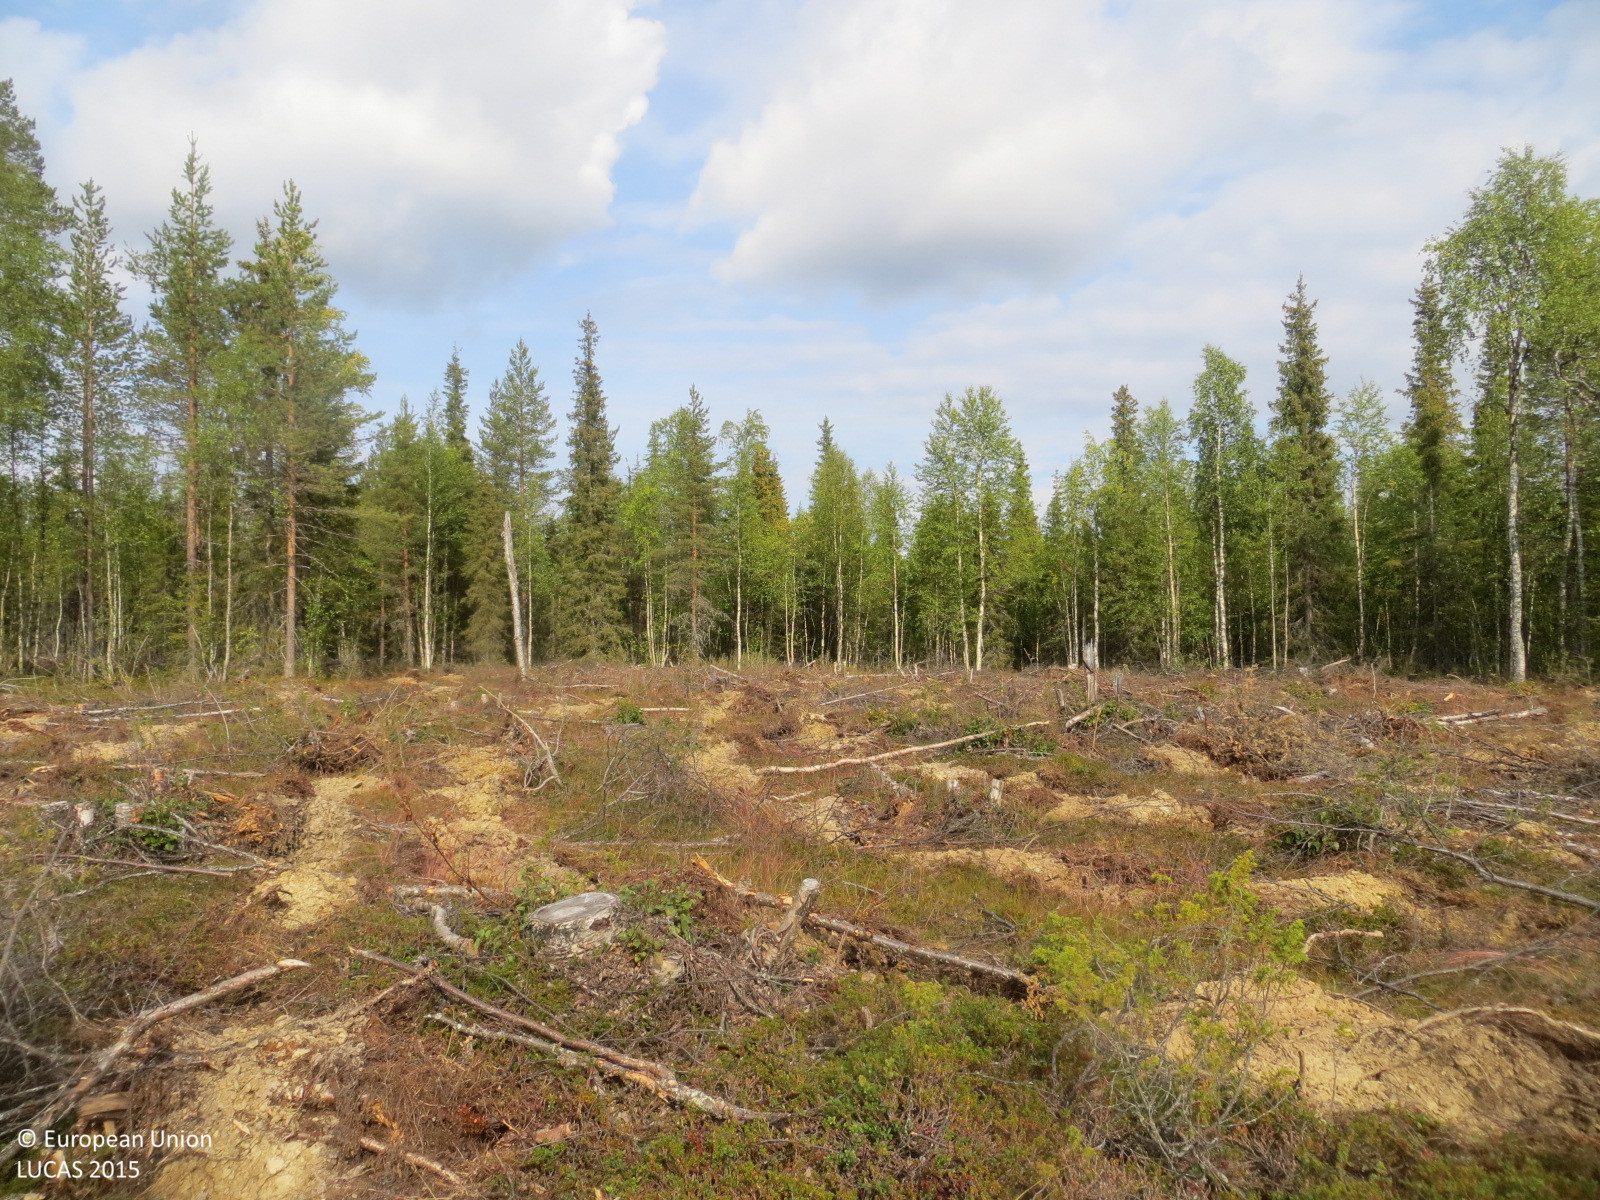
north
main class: Shrubland
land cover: Shrubland with sparse tree cover
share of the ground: > 75 %
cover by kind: shrubs 70 %, unconsolidated bare surface 10 %, coniferous forest trees 5 %, consolidated bare surface 5 %
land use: Forestry
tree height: > 5 m
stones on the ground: 25 - 50 %
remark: Clear cut
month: August
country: FI
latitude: 67.9312
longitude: 25.4728
